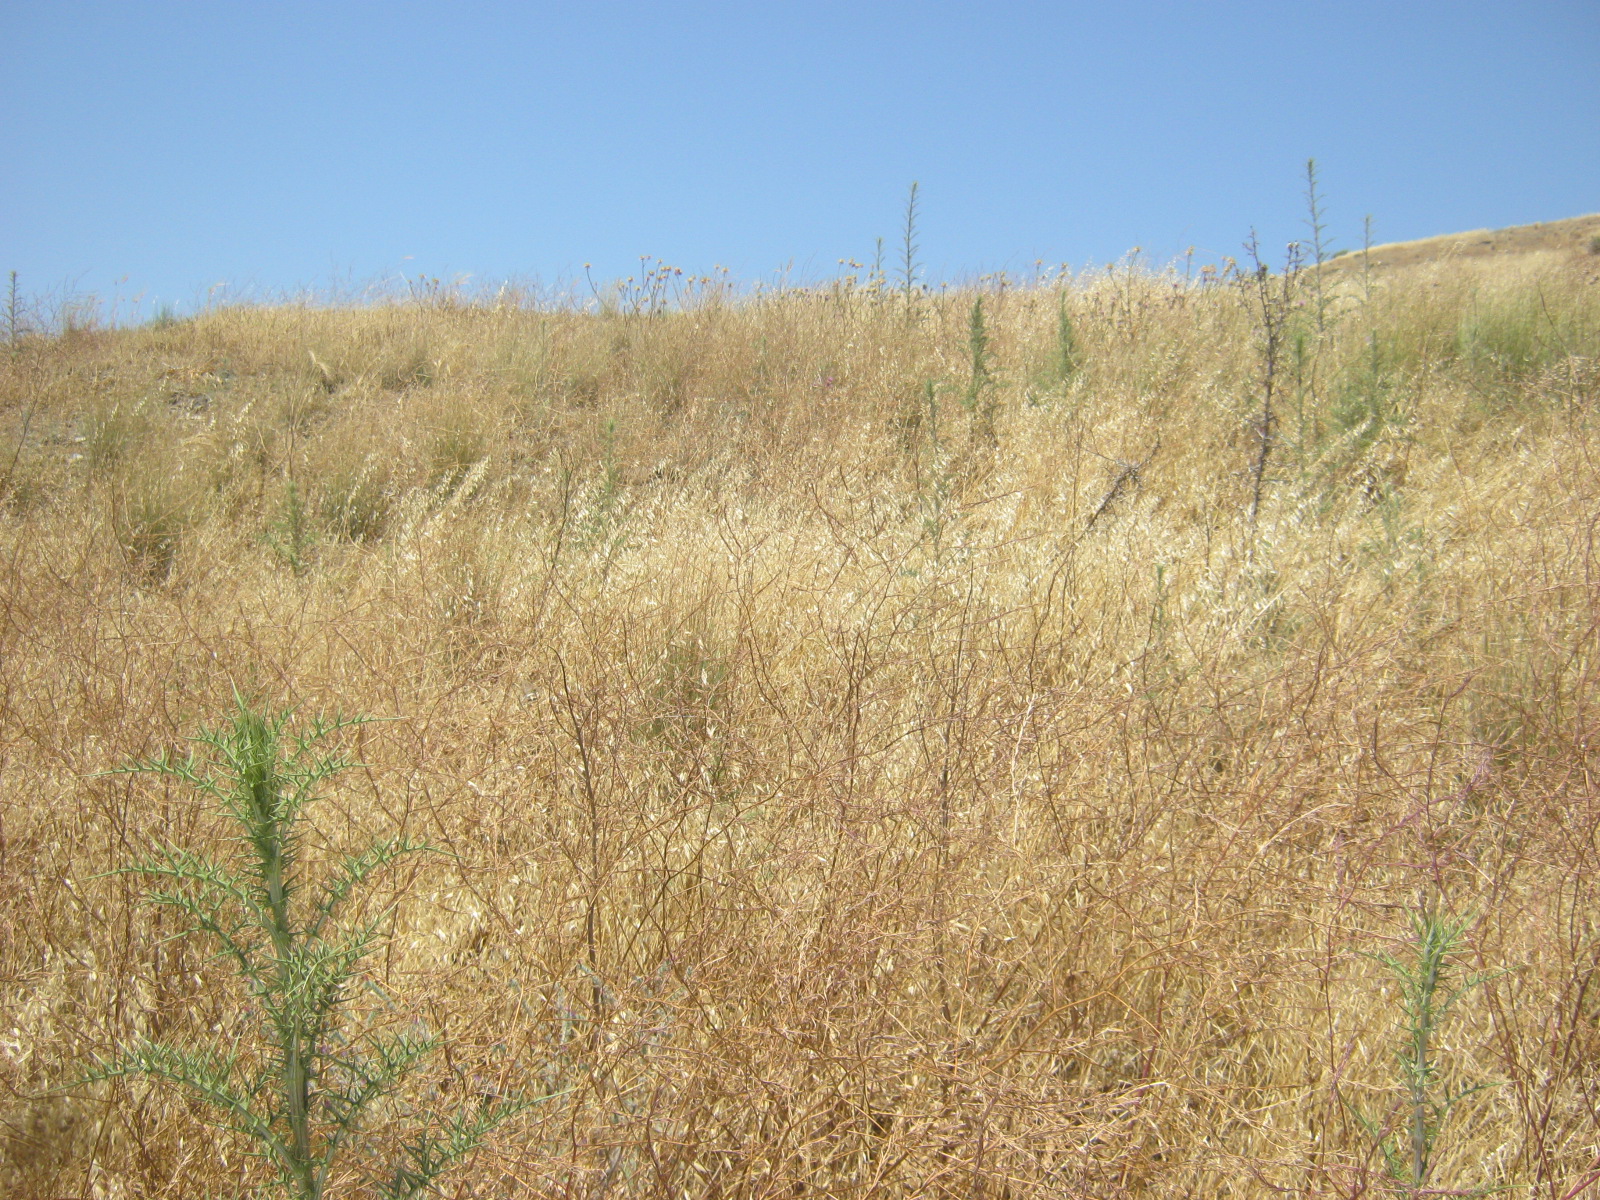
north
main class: Grassland
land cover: Spontaneously vegetated surfaces
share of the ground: 50 - 75 %
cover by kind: herbaceous plants 100 %
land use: Semi-natural and natural areas not in use
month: May
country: CY
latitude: 35.1007
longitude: 33.1207
